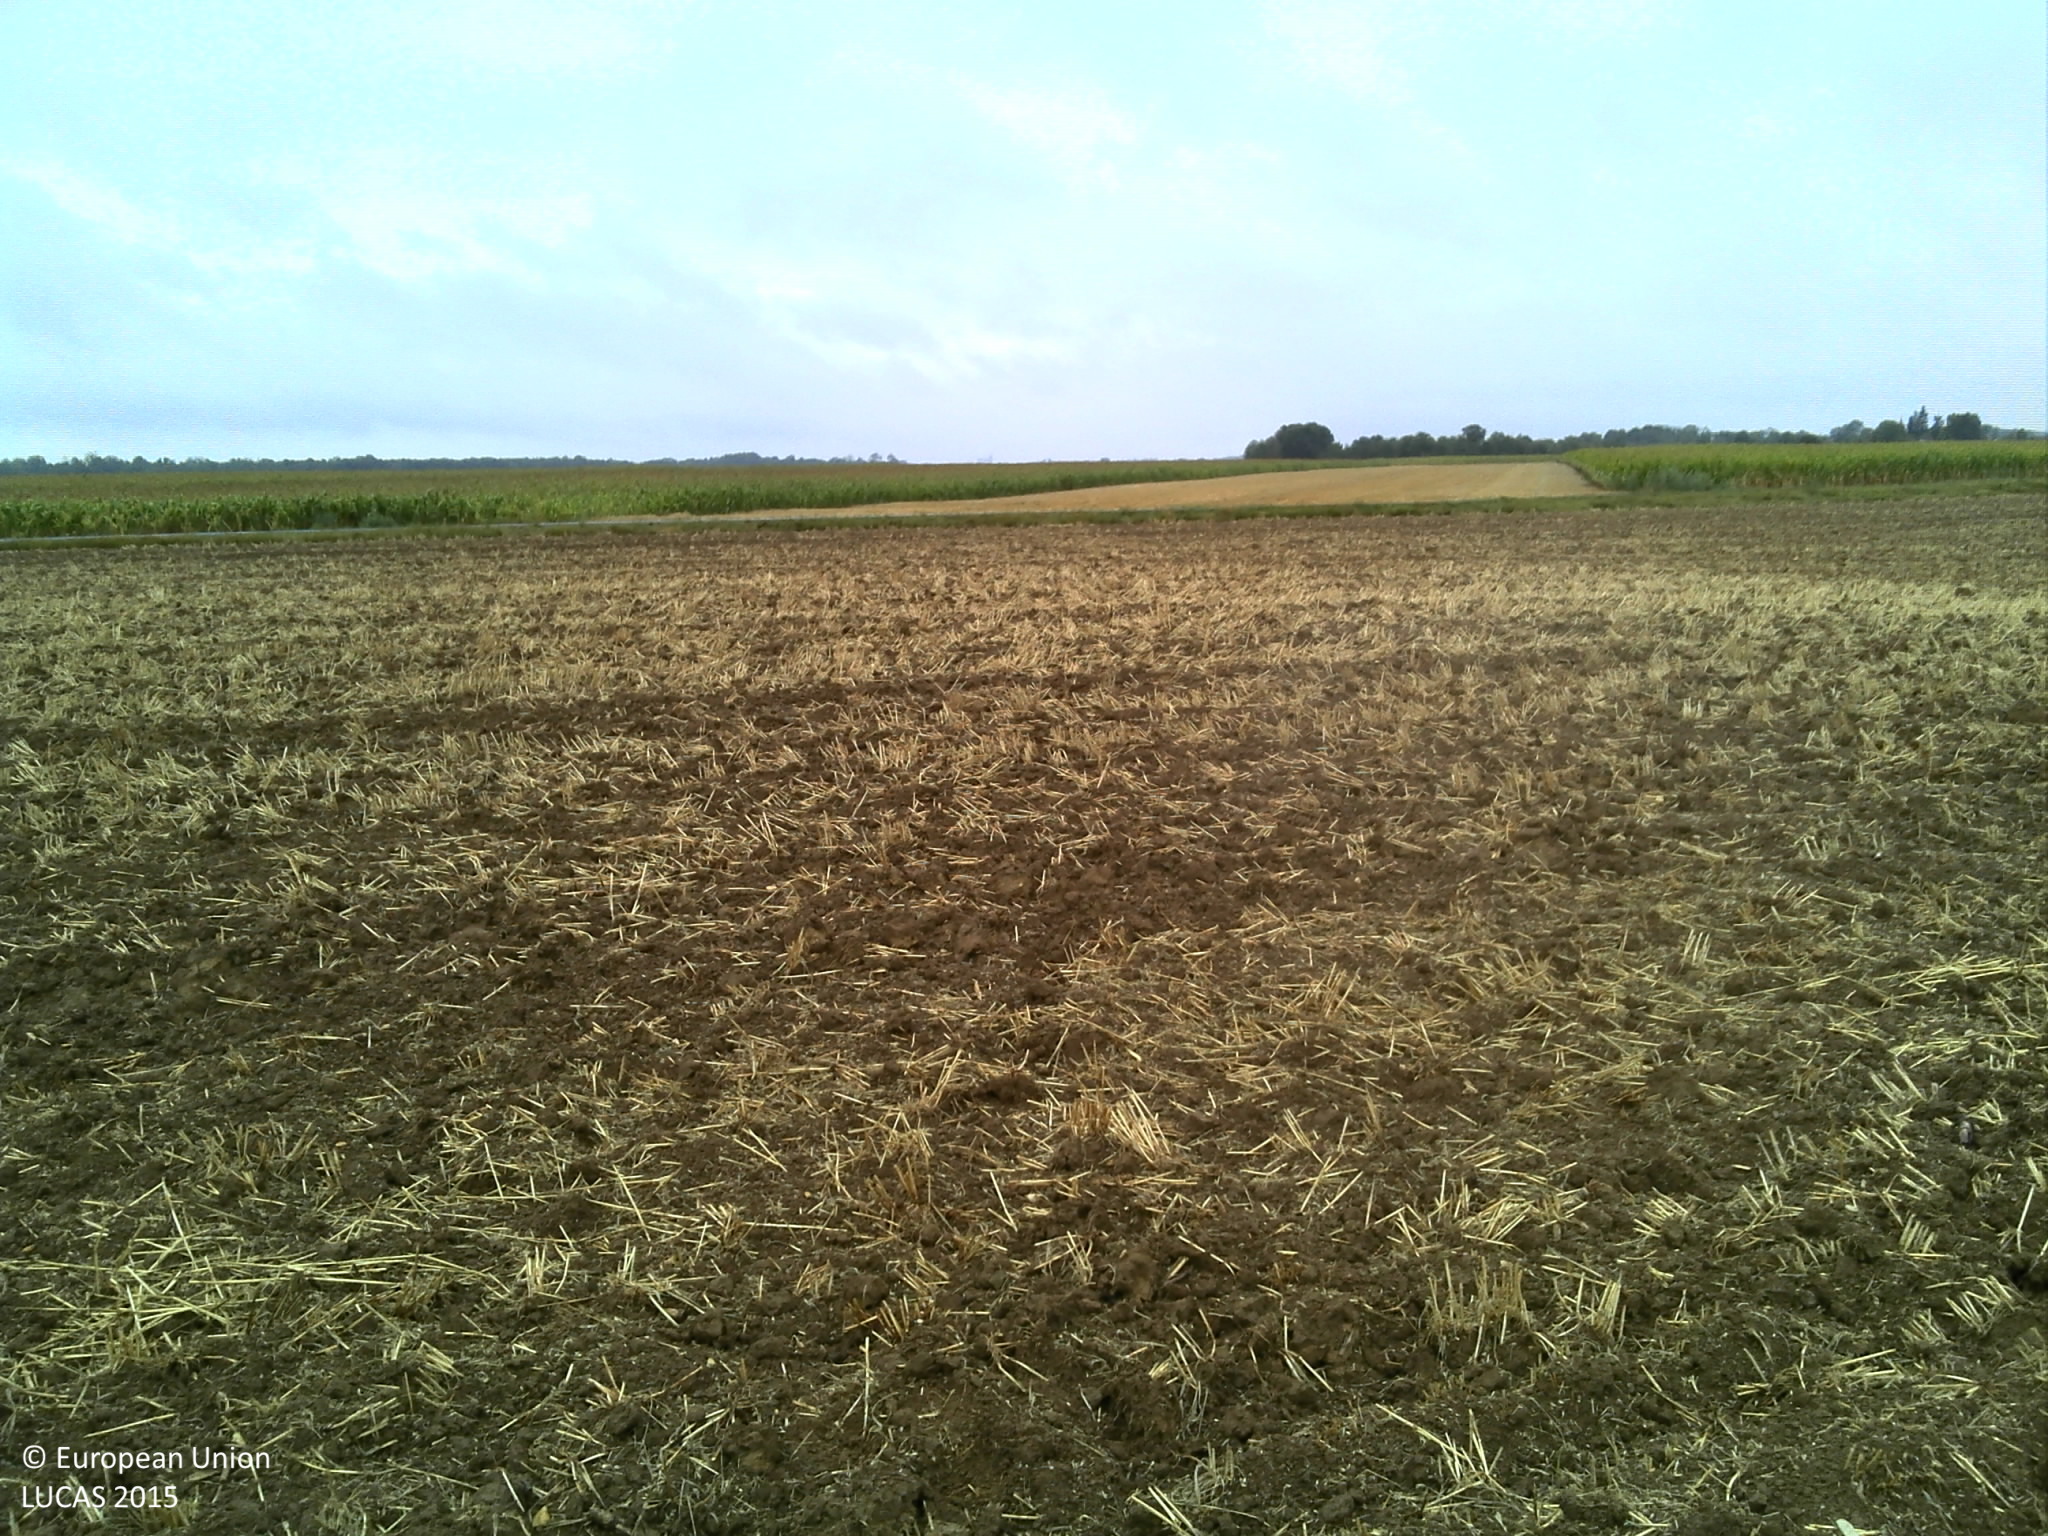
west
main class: Cropland
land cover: Common wheat
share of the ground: > 75 %
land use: Agriculture (excluding fallow land and kitchen gardens)
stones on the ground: < 10 %
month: August
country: FR
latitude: 48.6802
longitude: 4.8503
